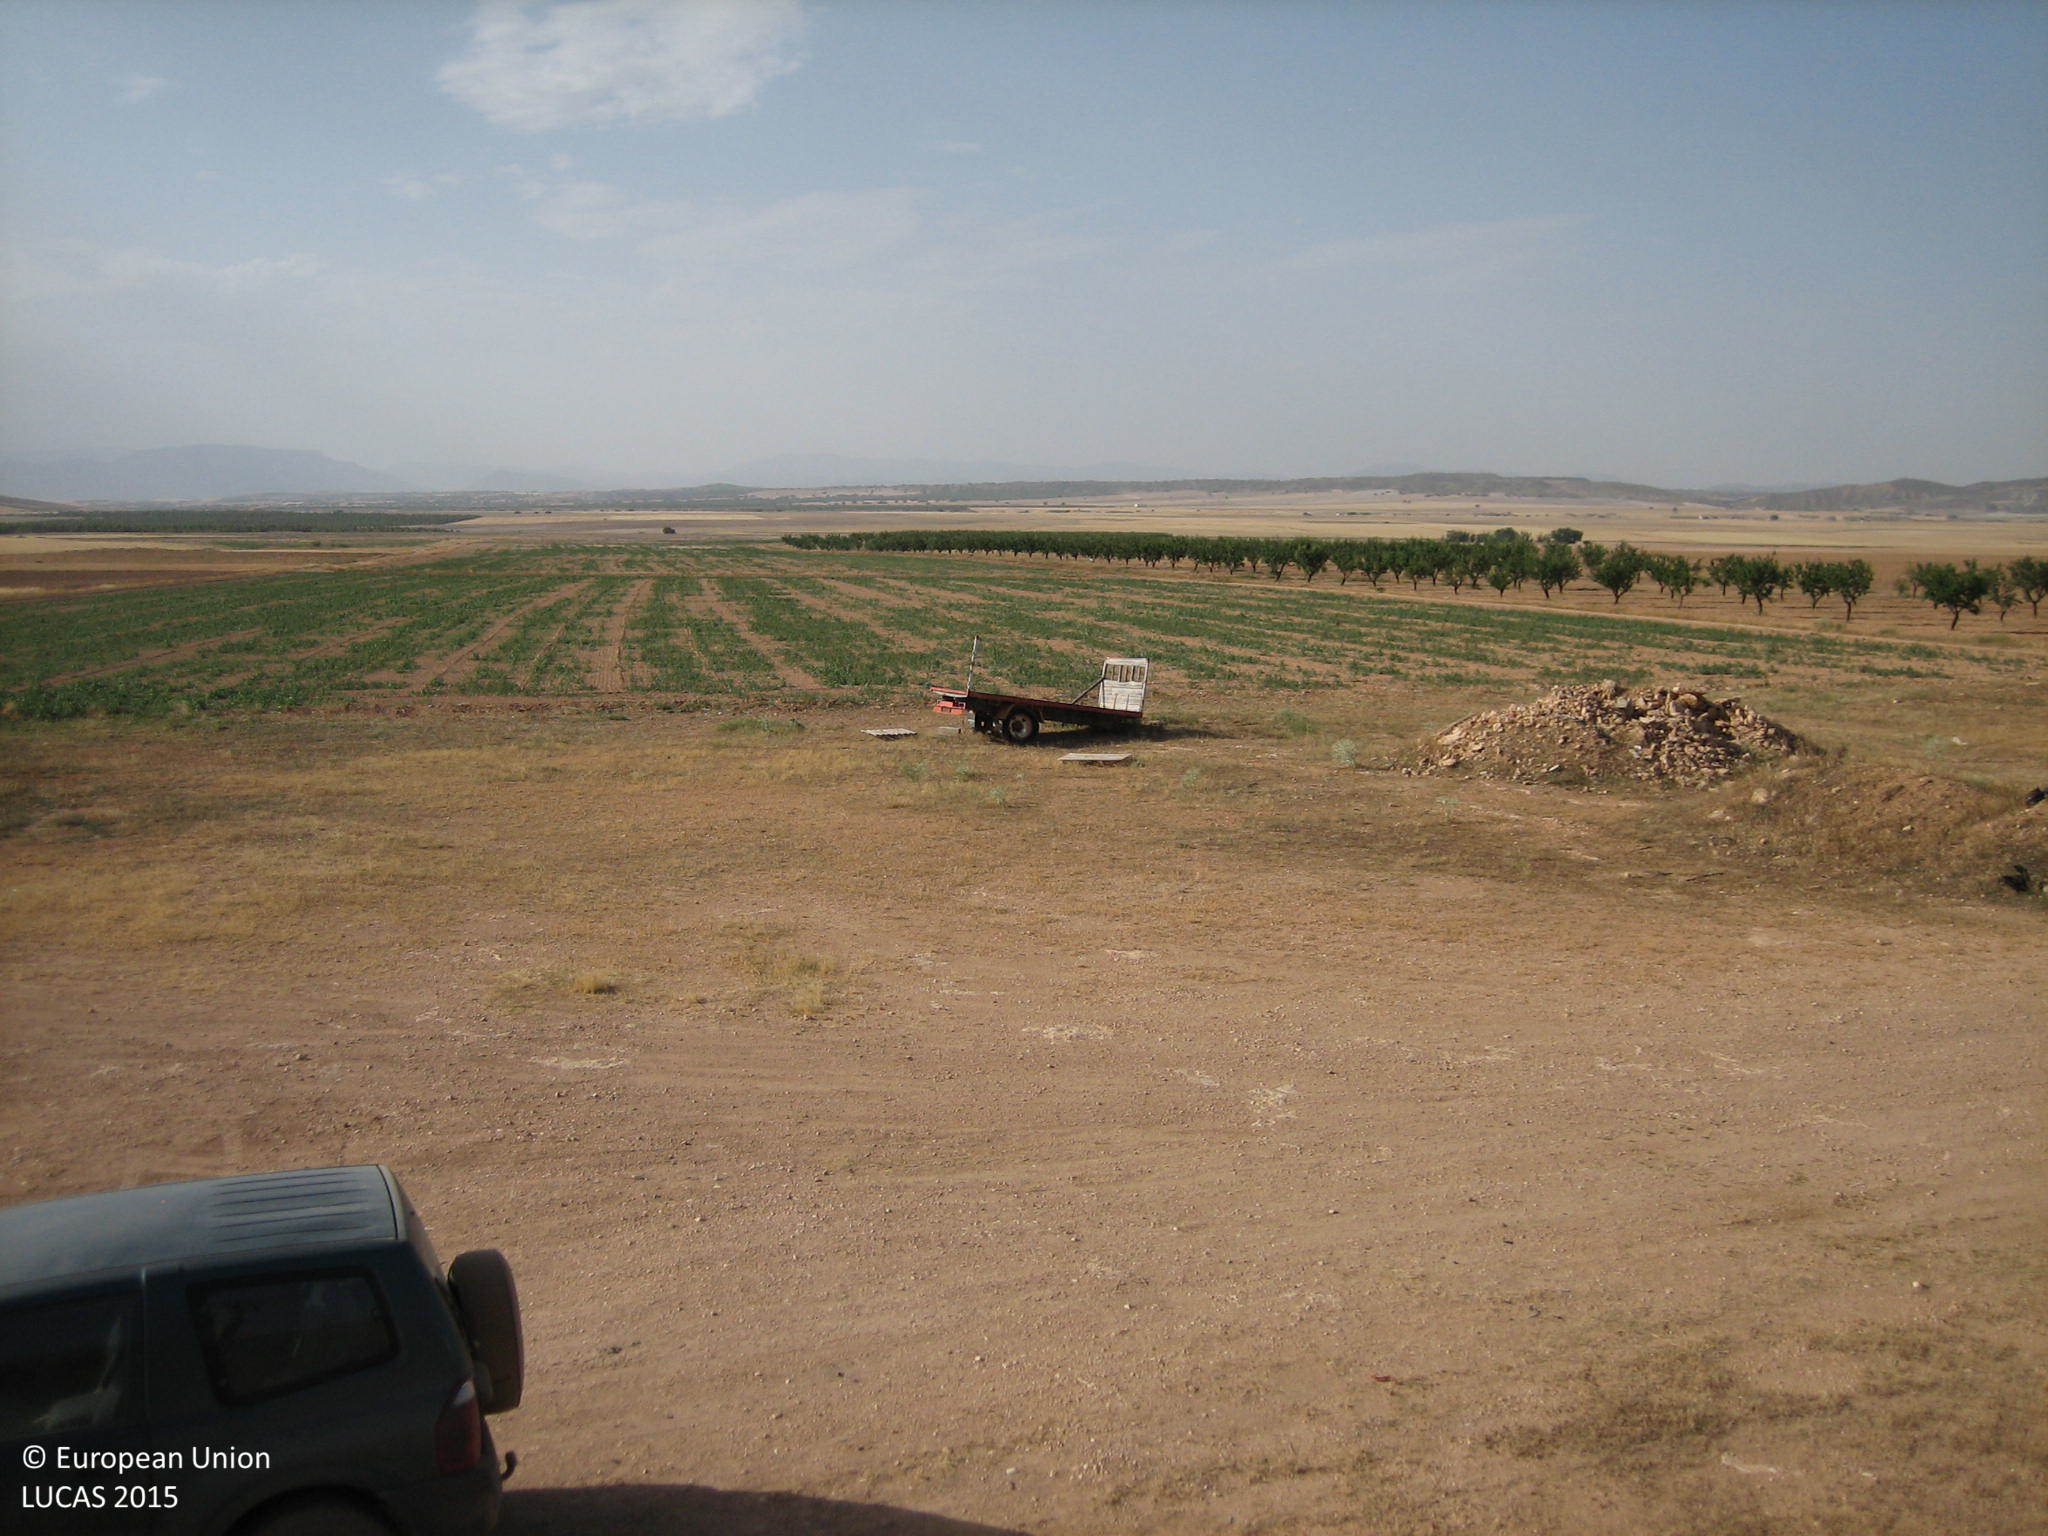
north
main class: Grassland
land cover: Grassland without tree/shrub cover
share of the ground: 50 - 75 %
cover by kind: herbaceous plants 60 %, unconsolidated bare surface 40 %
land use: Protection infrastructures
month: July
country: ES
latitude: 37.6892
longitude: -2.3591
